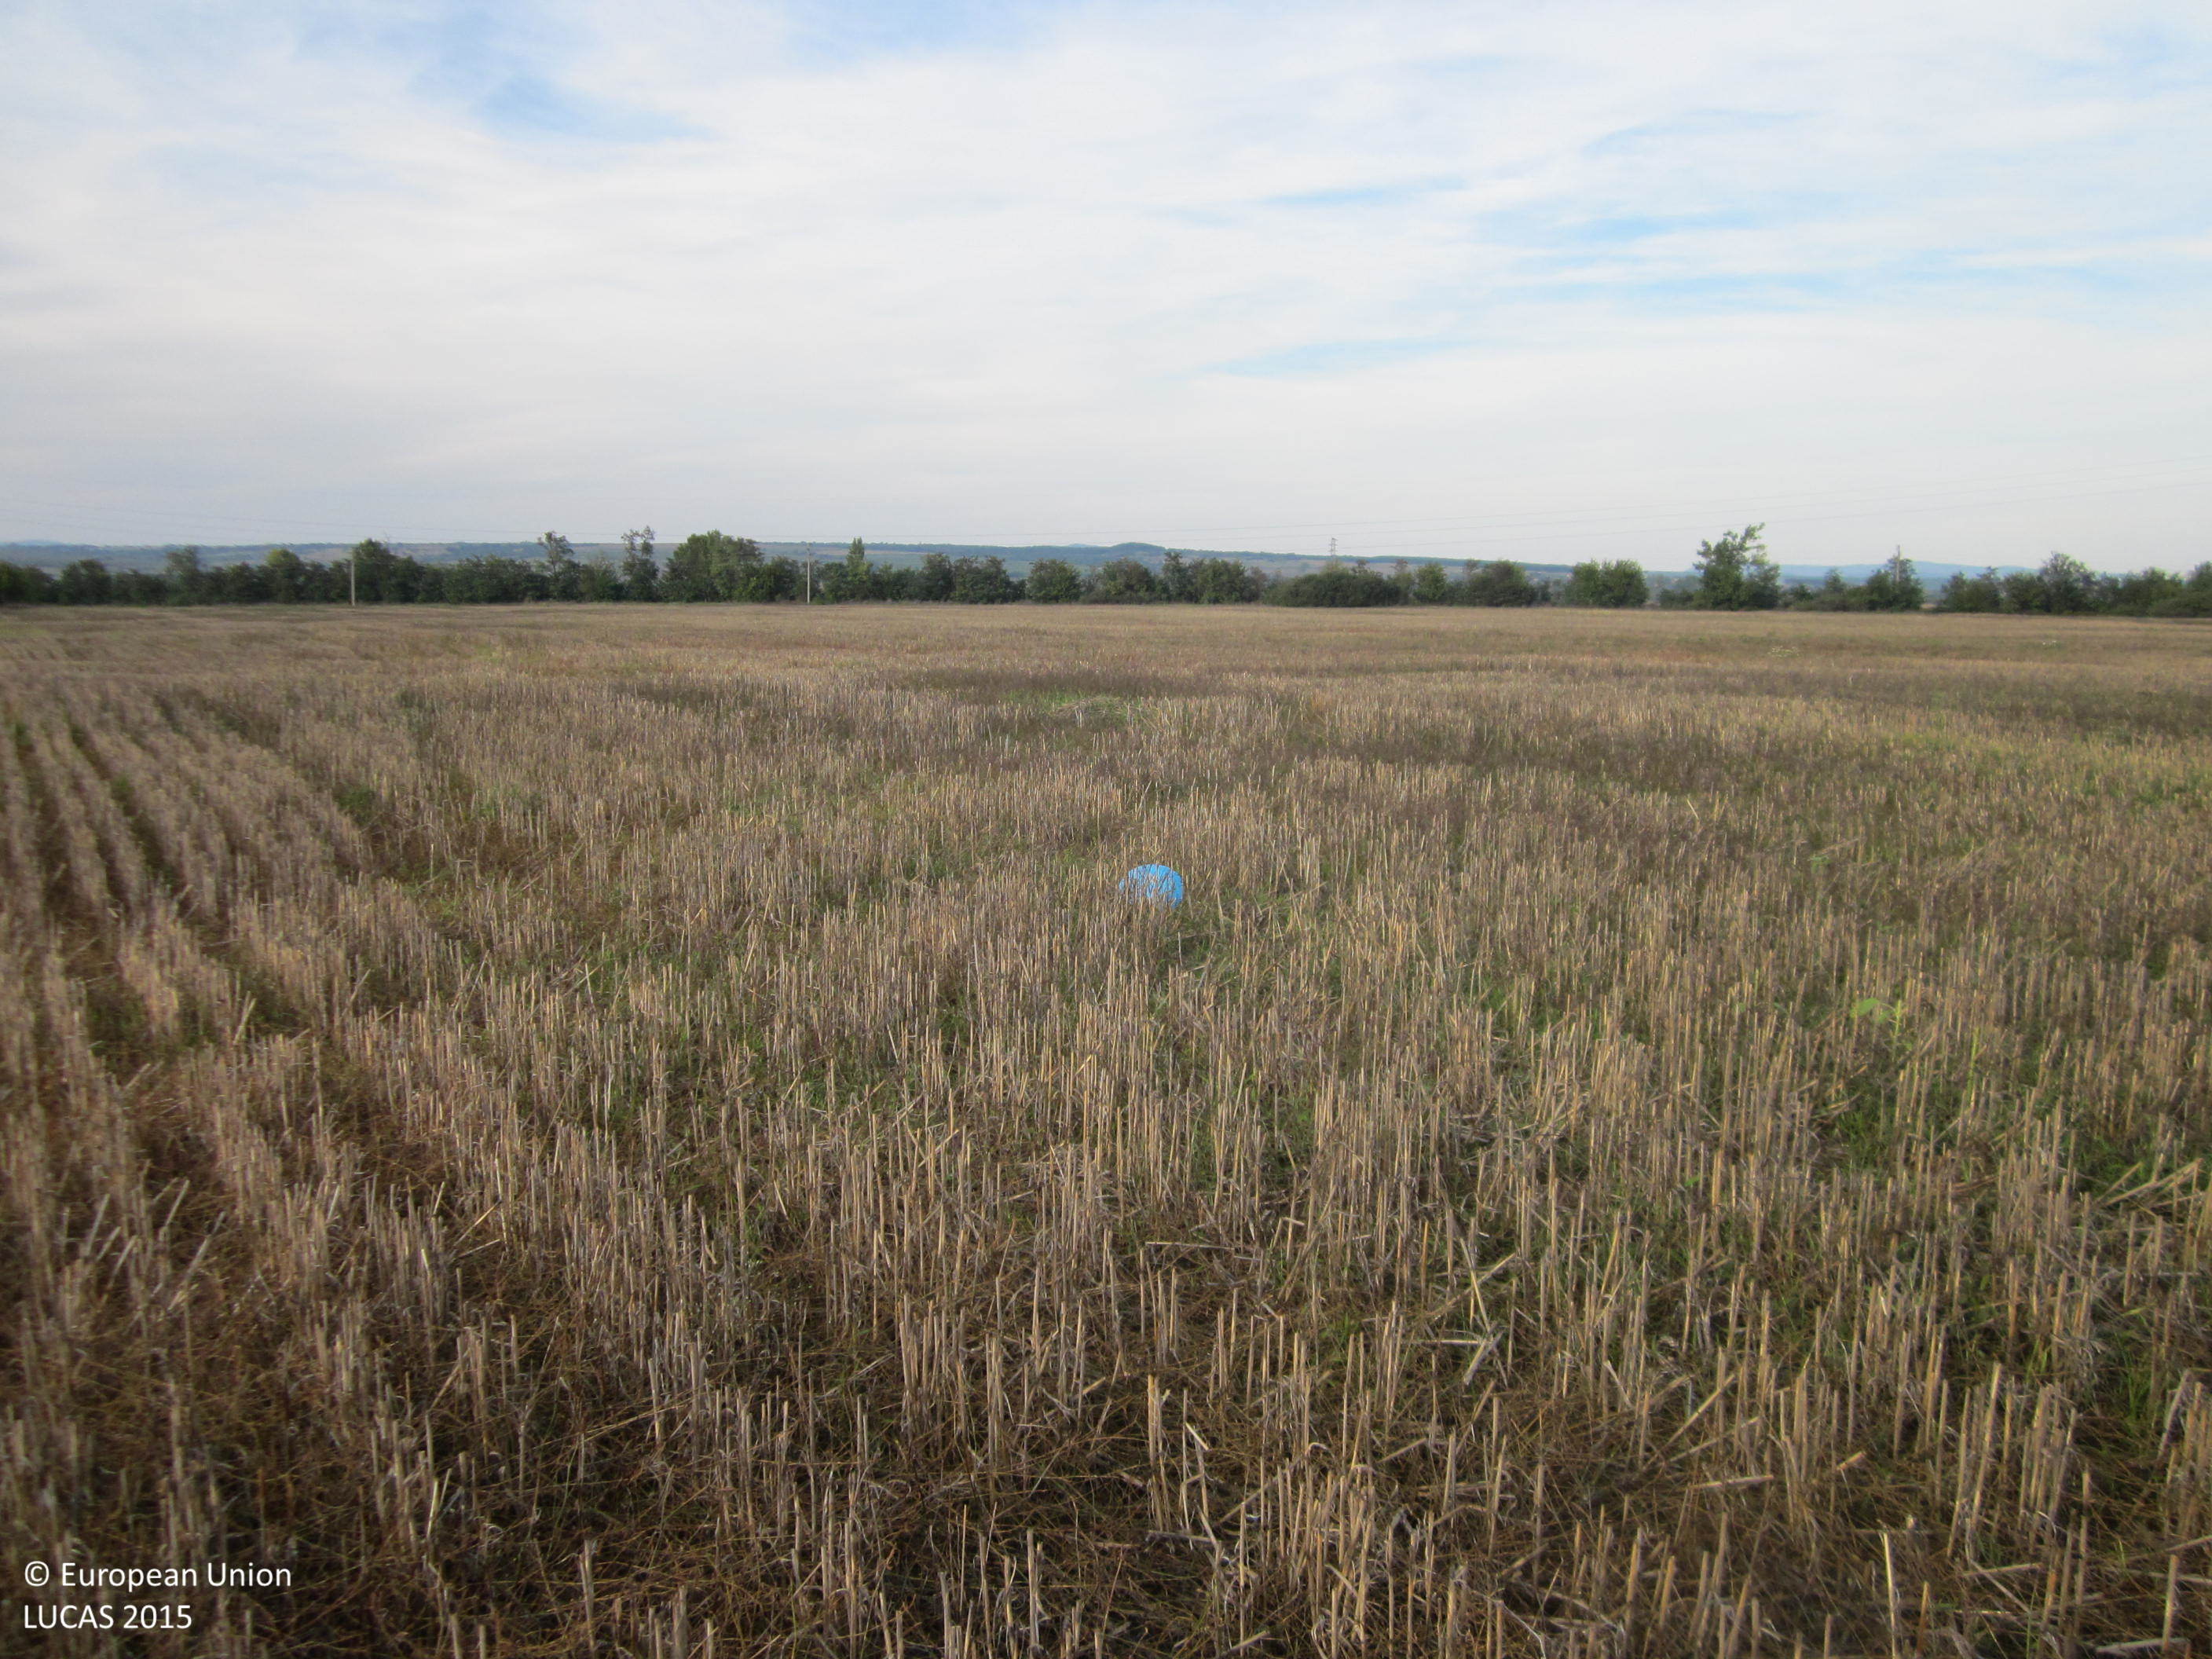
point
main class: Cropland
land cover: Common wheat
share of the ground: 50 - 75 %
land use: Agriculture (excluding fallow land and kitchen gardens)
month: October
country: BG
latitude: 42.7475
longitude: 26.8033
